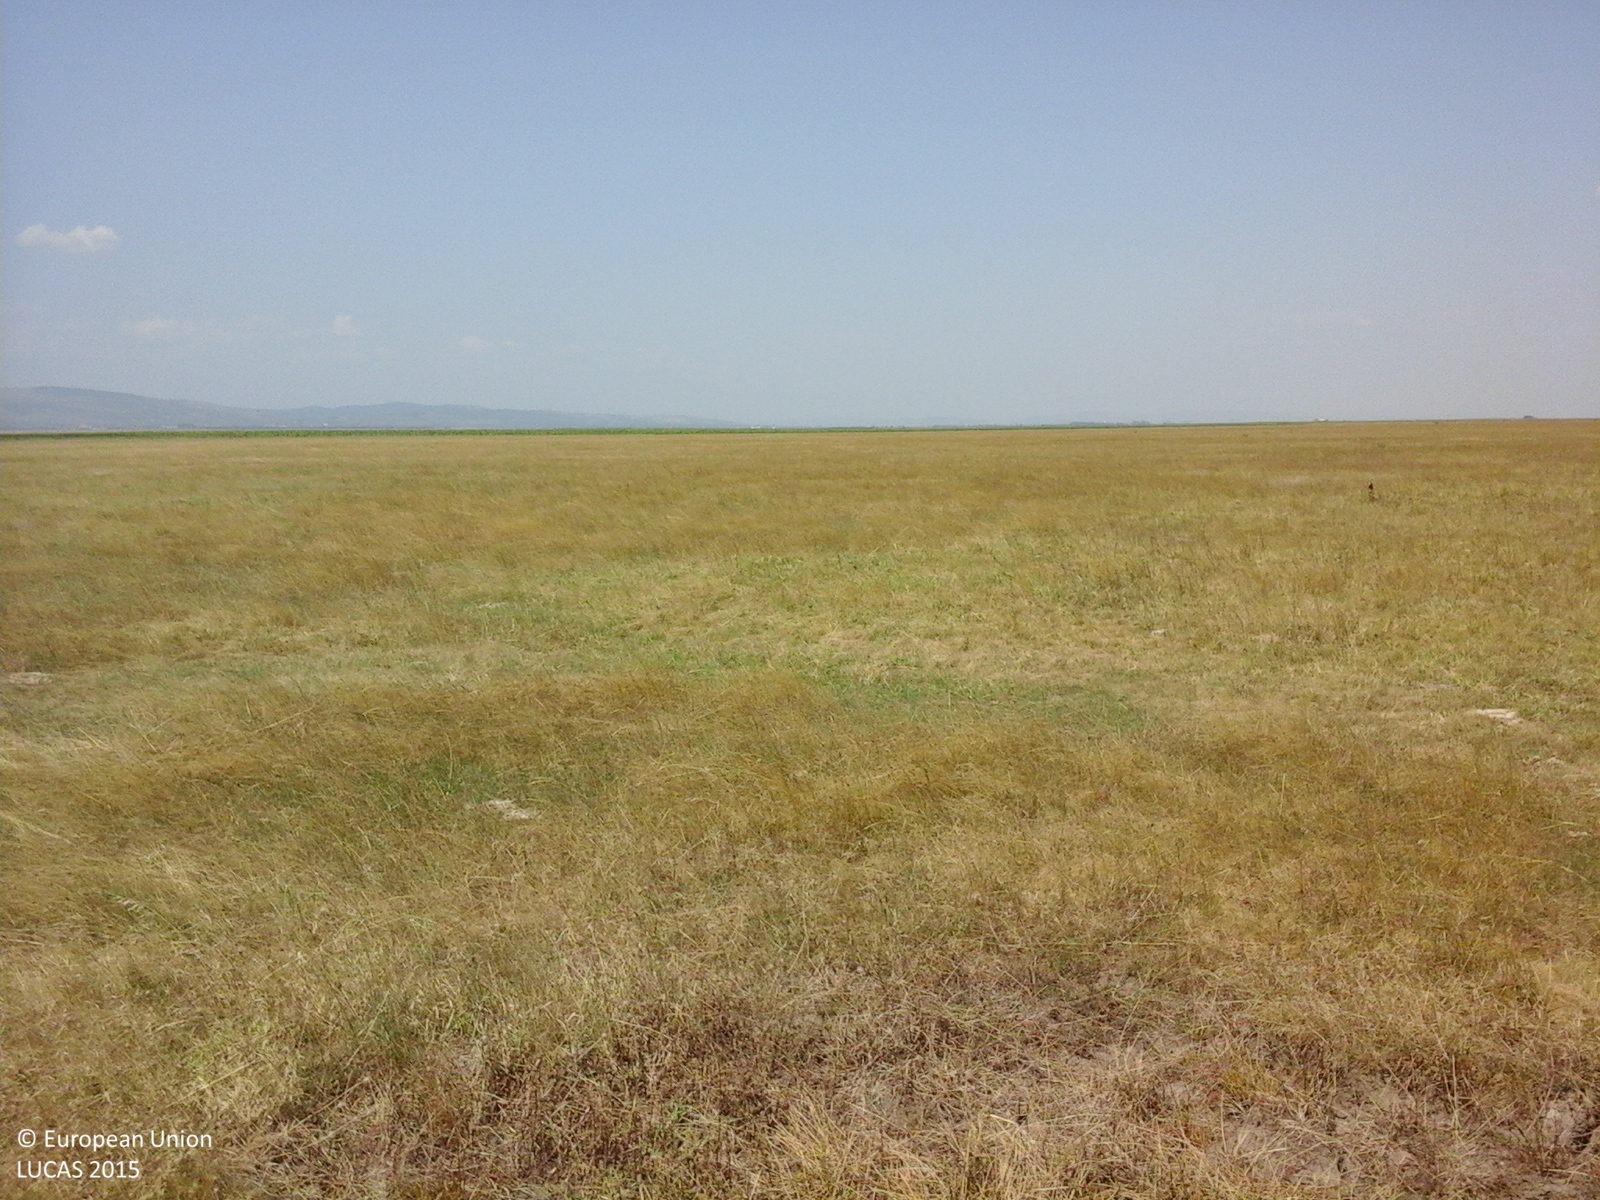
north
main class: Grassland
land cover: Grassland without tree/shrub cover
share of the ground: > 75 %
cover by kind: herbaceous plants 100 %
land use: Agriculture (excluding fallow land and kitchen gardens)
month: August
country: RO
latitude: 45.0106
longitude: 26.6838
